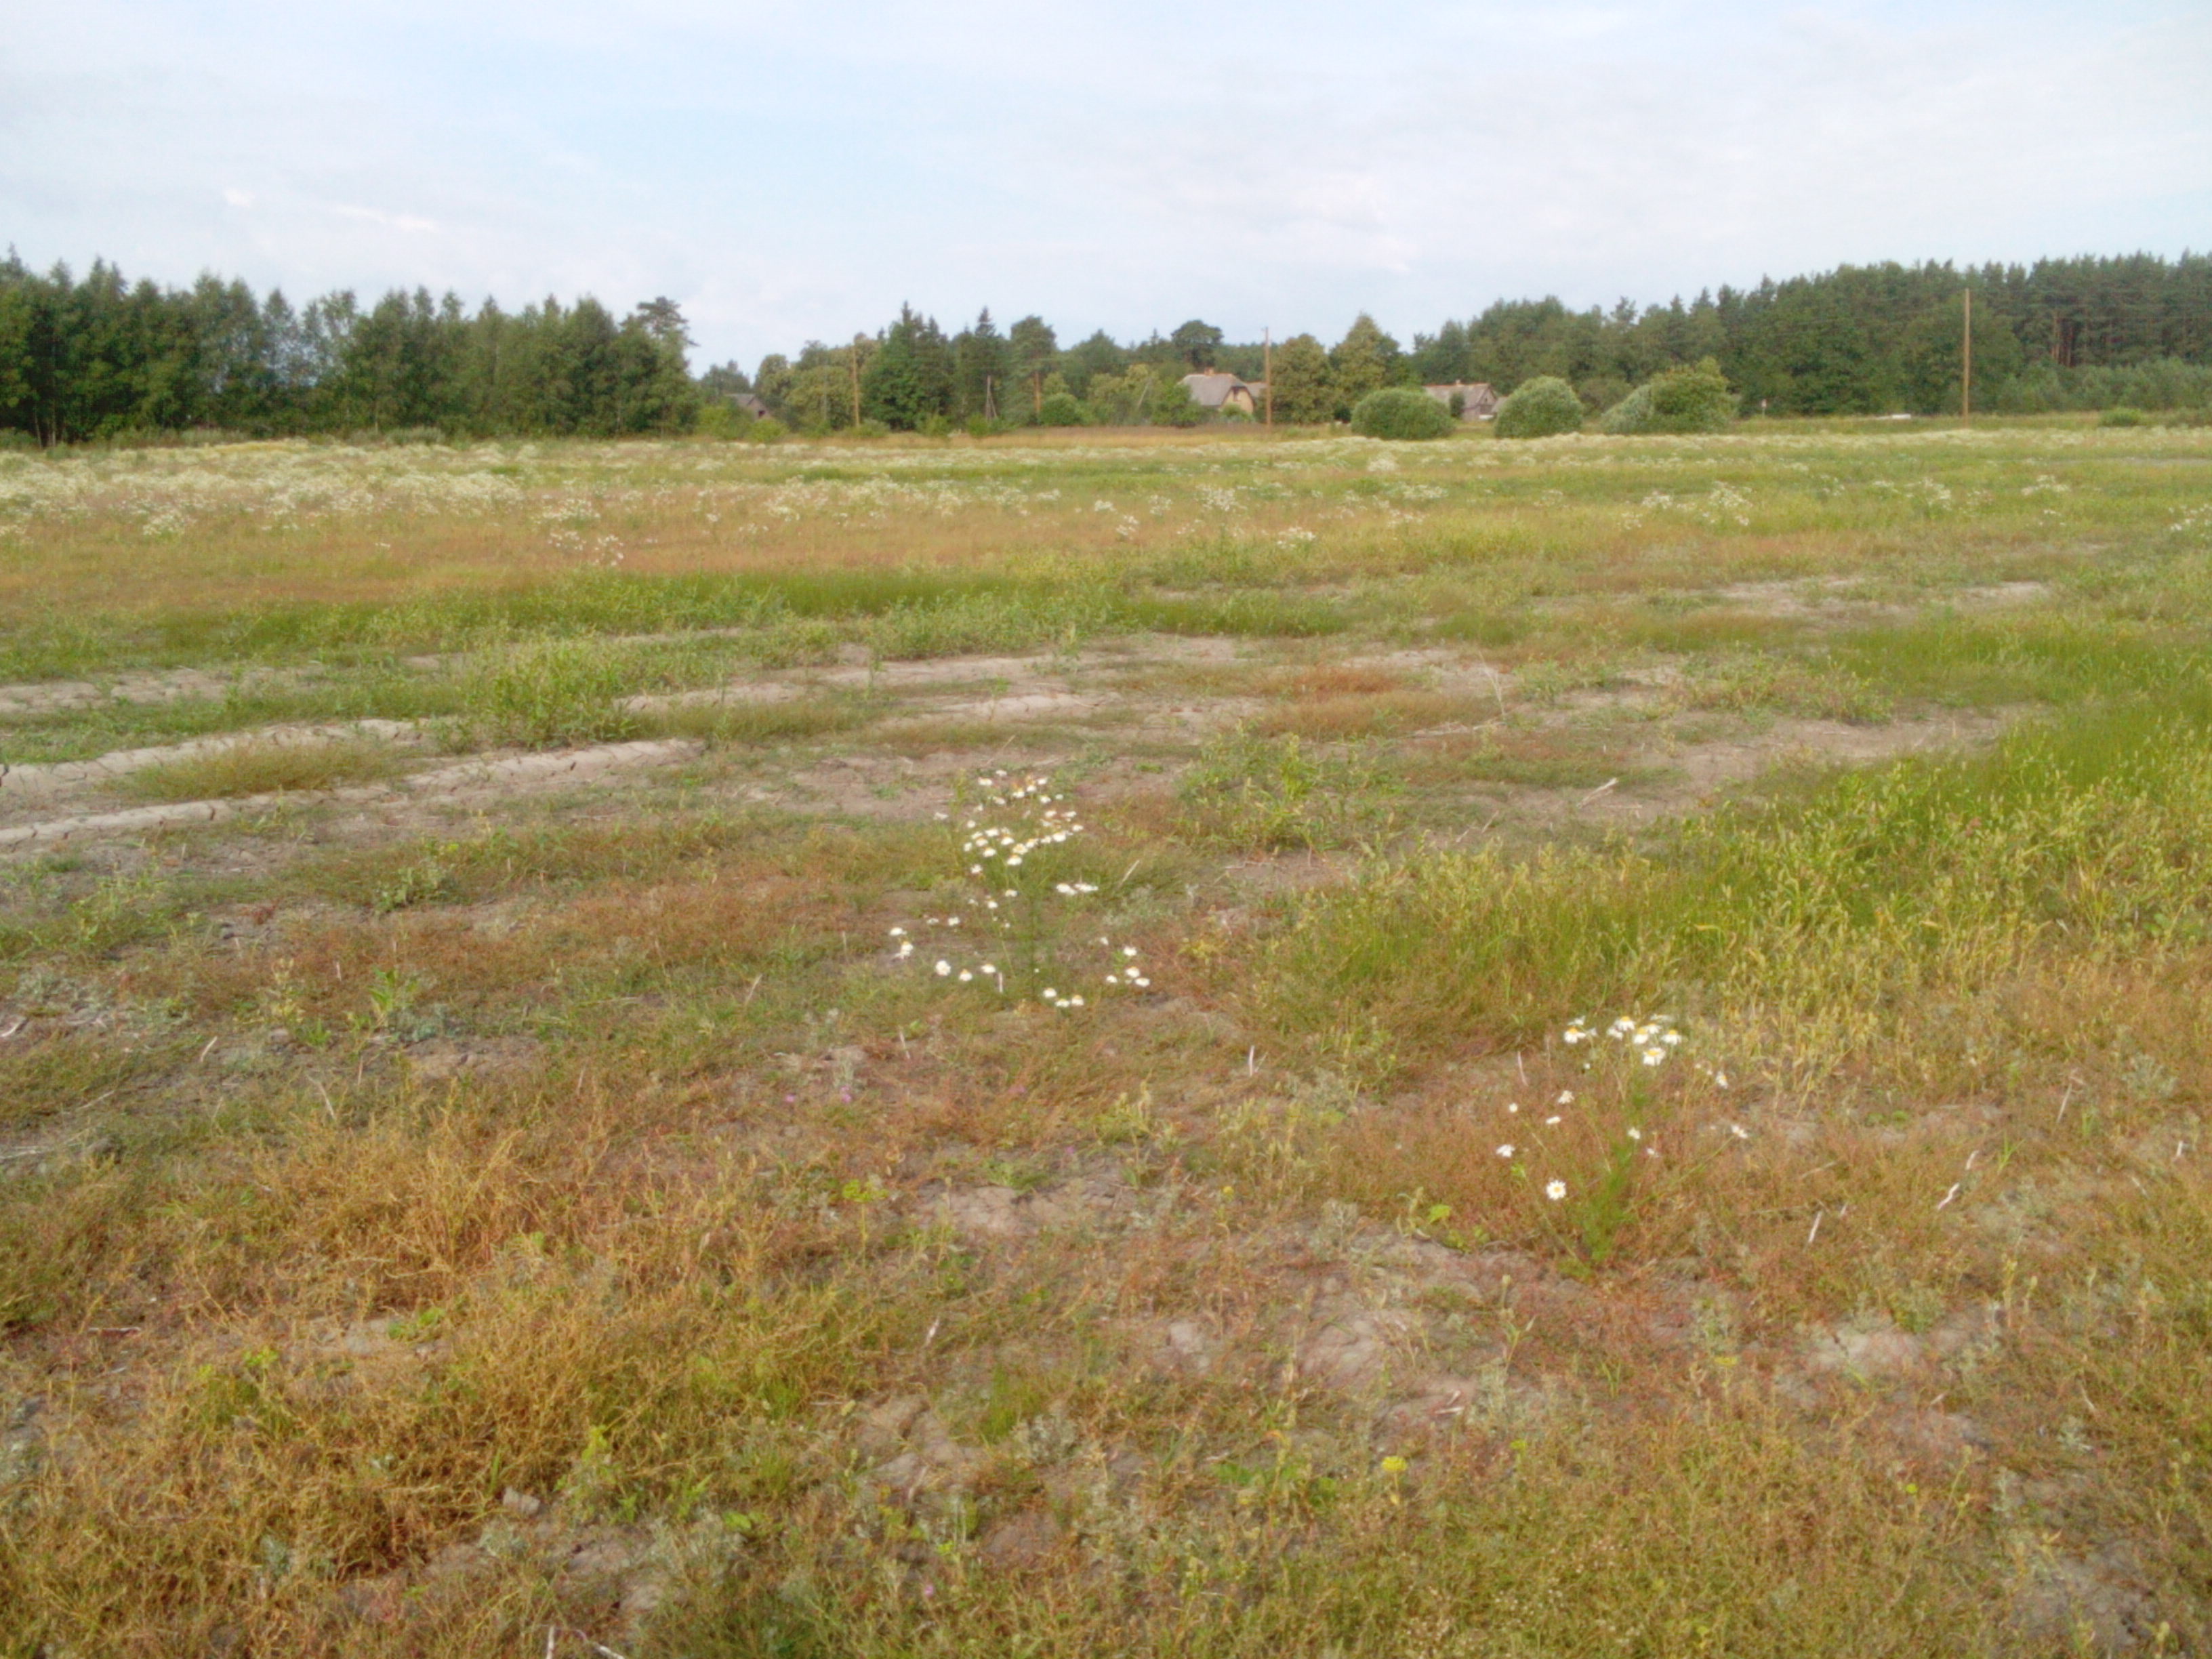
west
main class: Grassland
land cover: Spontaneously vegetated surfaces
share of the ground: 50 - 75 %
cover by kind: herbaceous plants 70 %, unconsolidated bare surface 30 %
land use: Semi-natural and natural areas not in use
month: July
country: LV
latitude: 56.7830
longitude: 21.6477
